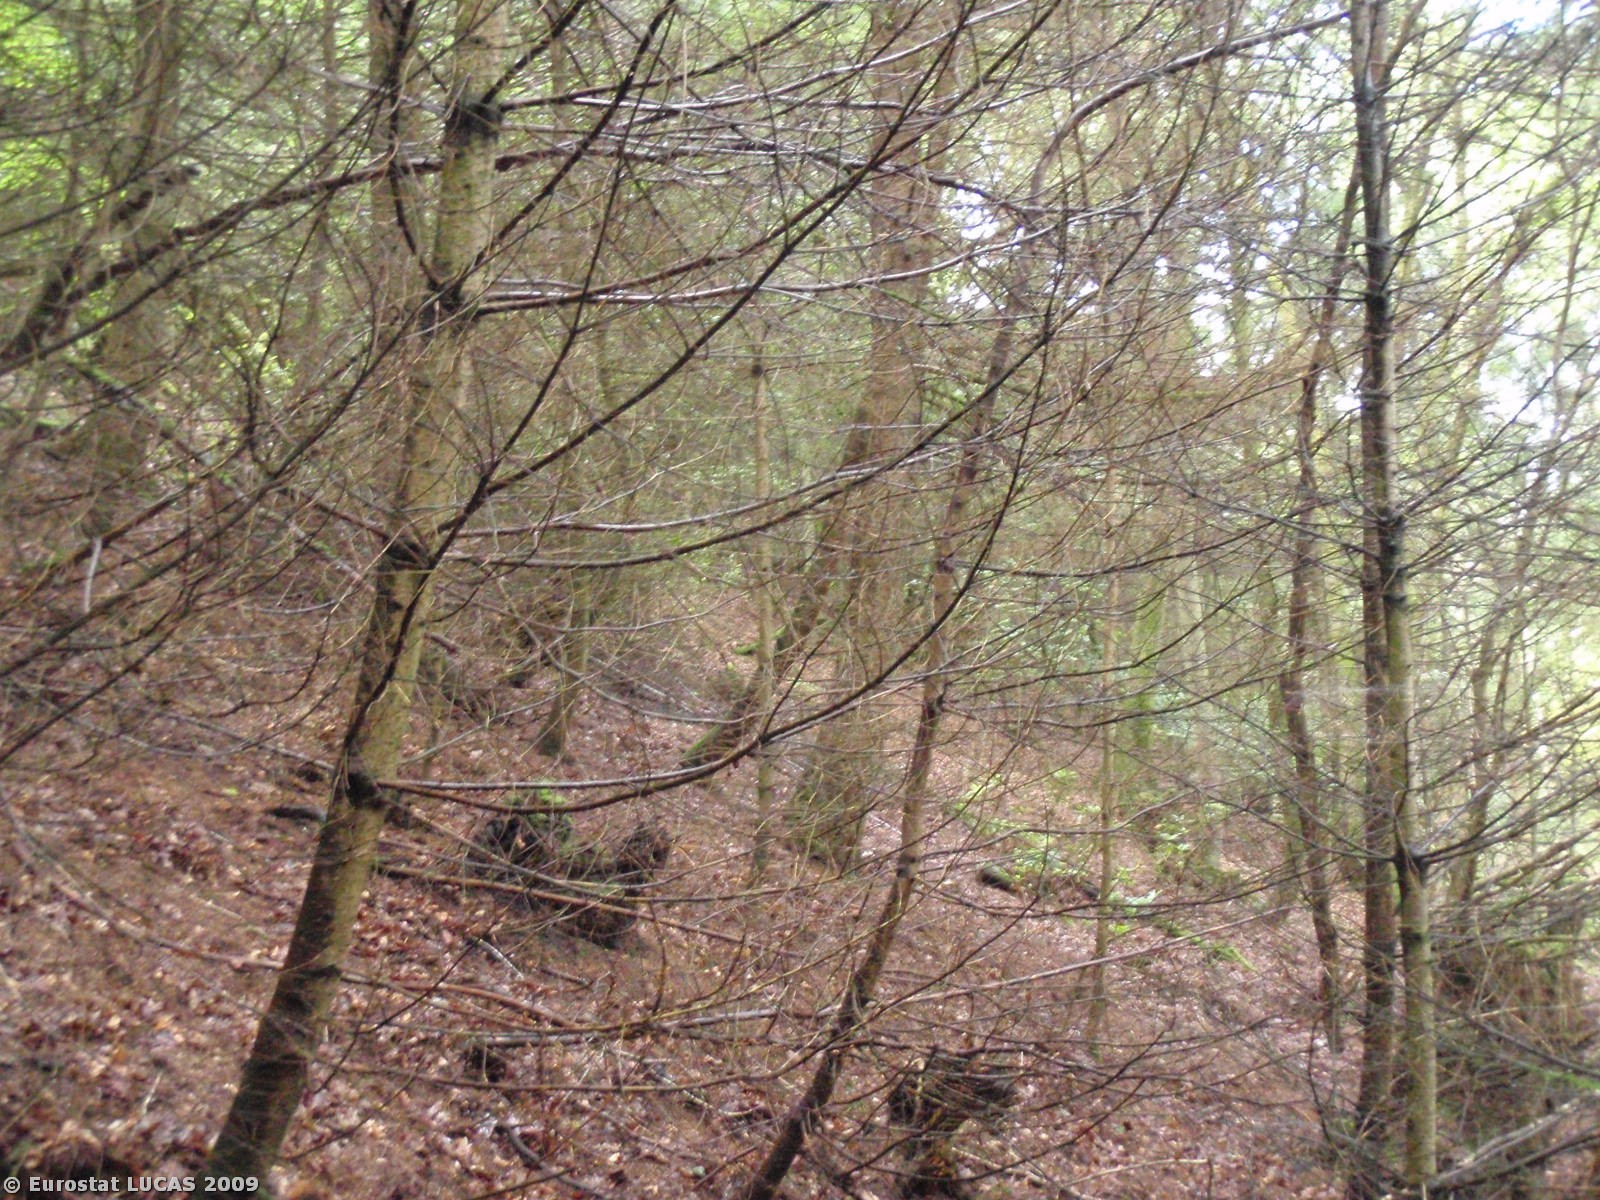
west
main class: Woodland
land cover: Coniferous woodland
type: plantations and self-sown exotic forest
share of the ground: > 75 %
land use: Forestry
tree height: > 5 m
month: August
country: GB
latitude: 51.1691
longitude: -3.4557
